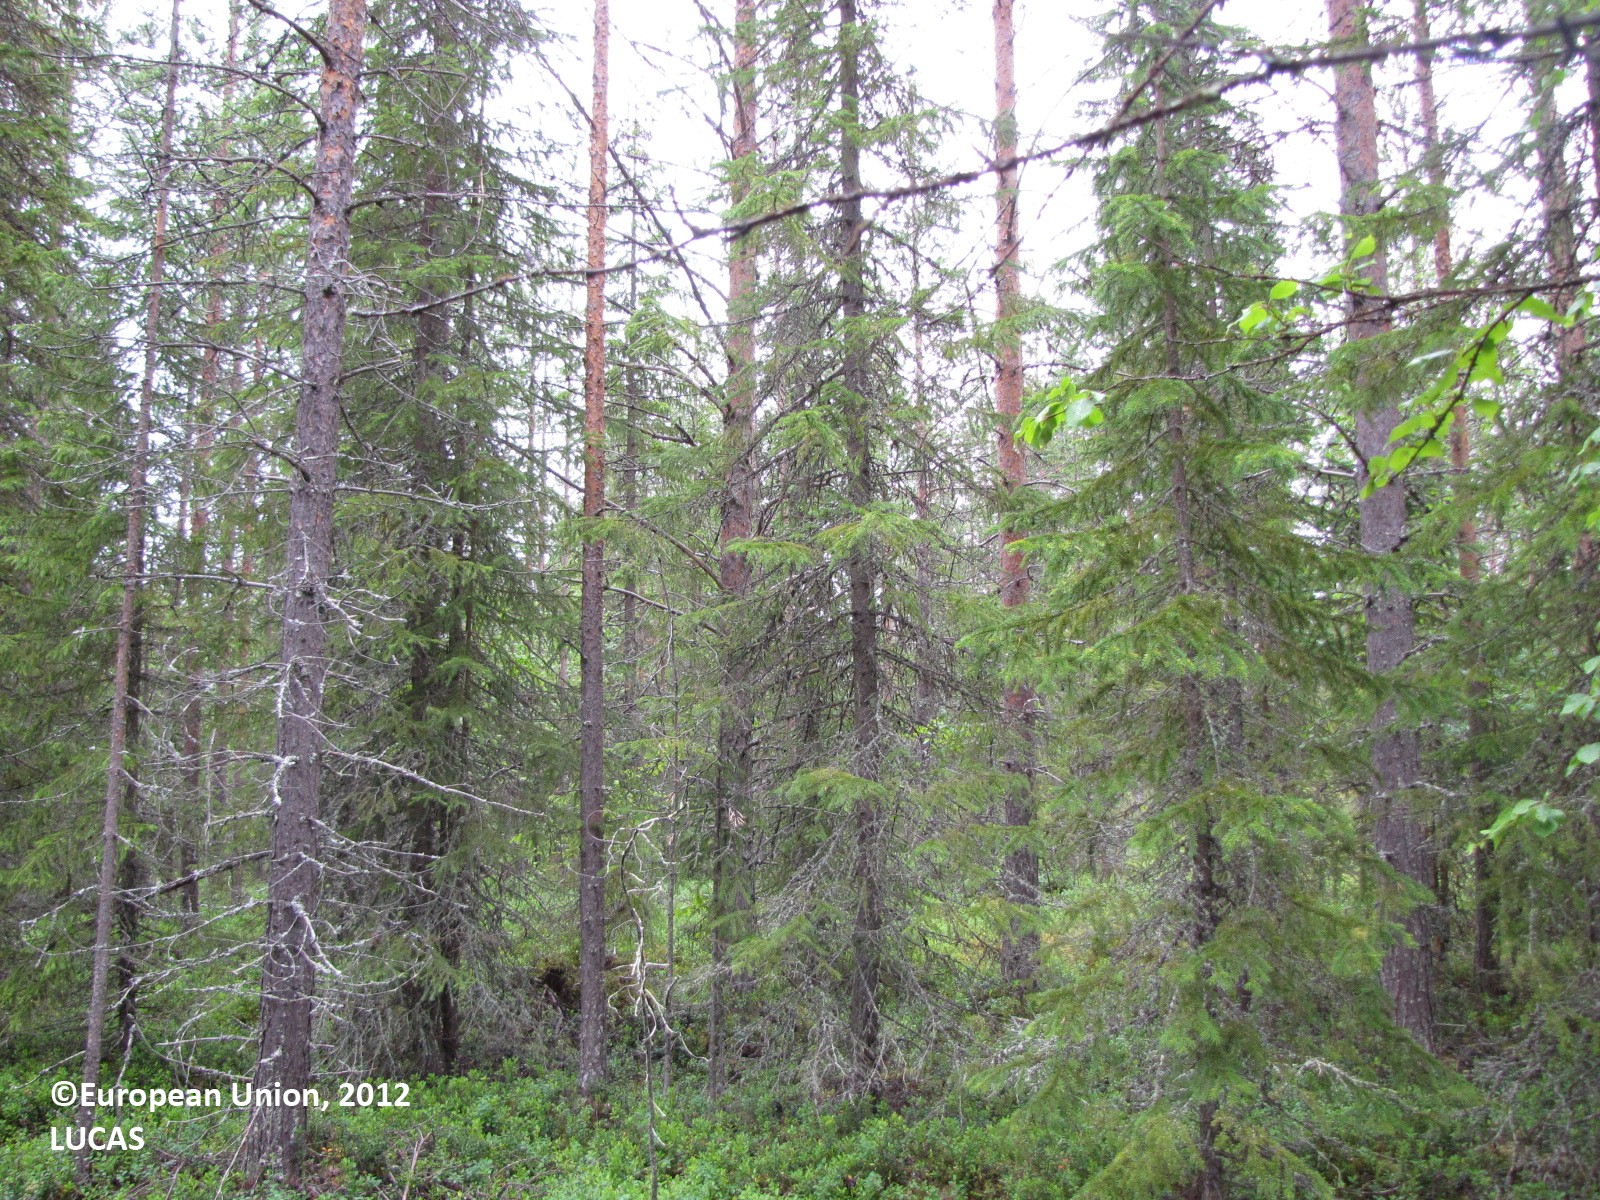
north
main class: Woodland
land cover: Other coniferous woodland
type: boreal forest
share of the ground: 50 - 75 %
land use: Forestry
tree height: > 5 m
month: July
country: FI
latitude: 66.6281
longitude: 24.8916
